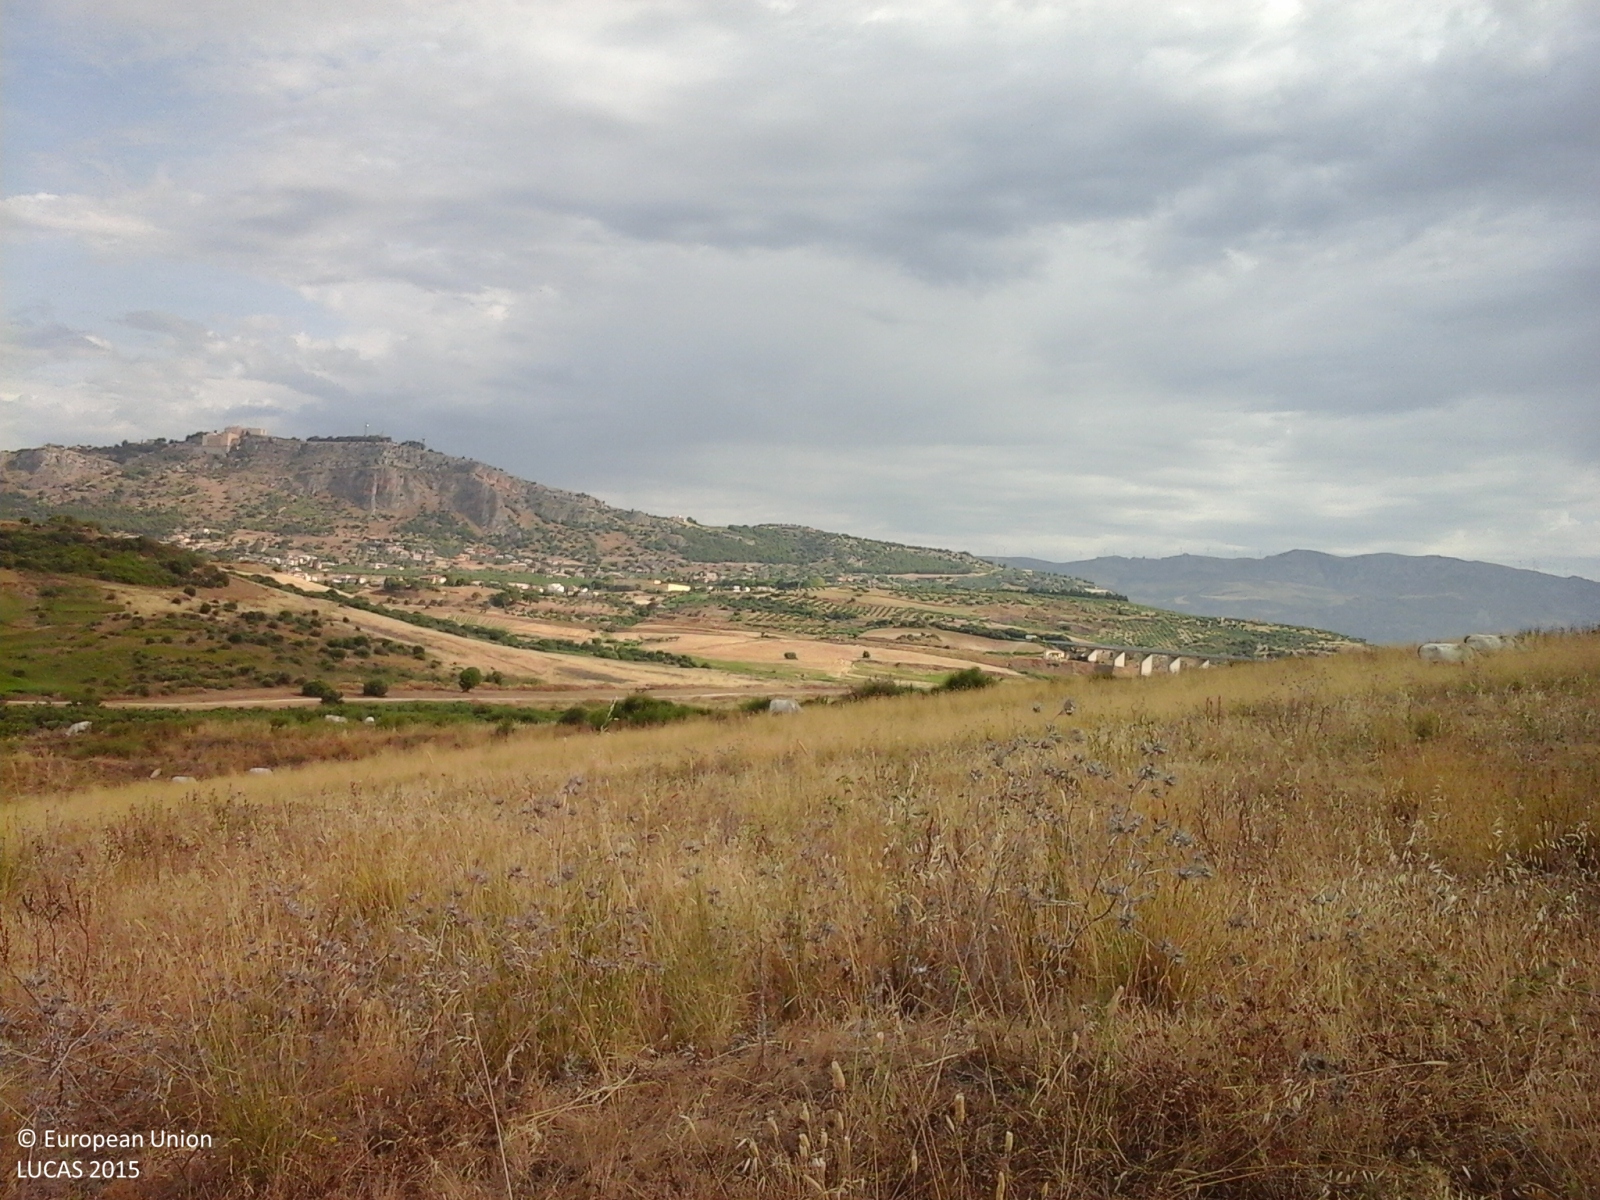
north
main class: Grassland
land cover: Grassland without tree/shrub cover
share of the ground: > 75 %
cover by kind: herbaceous plants 100 %
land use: Agriculture (excluding fallow land and kitchen gardens)
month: June
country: IT
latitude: 37.4961
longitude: 13.1317
